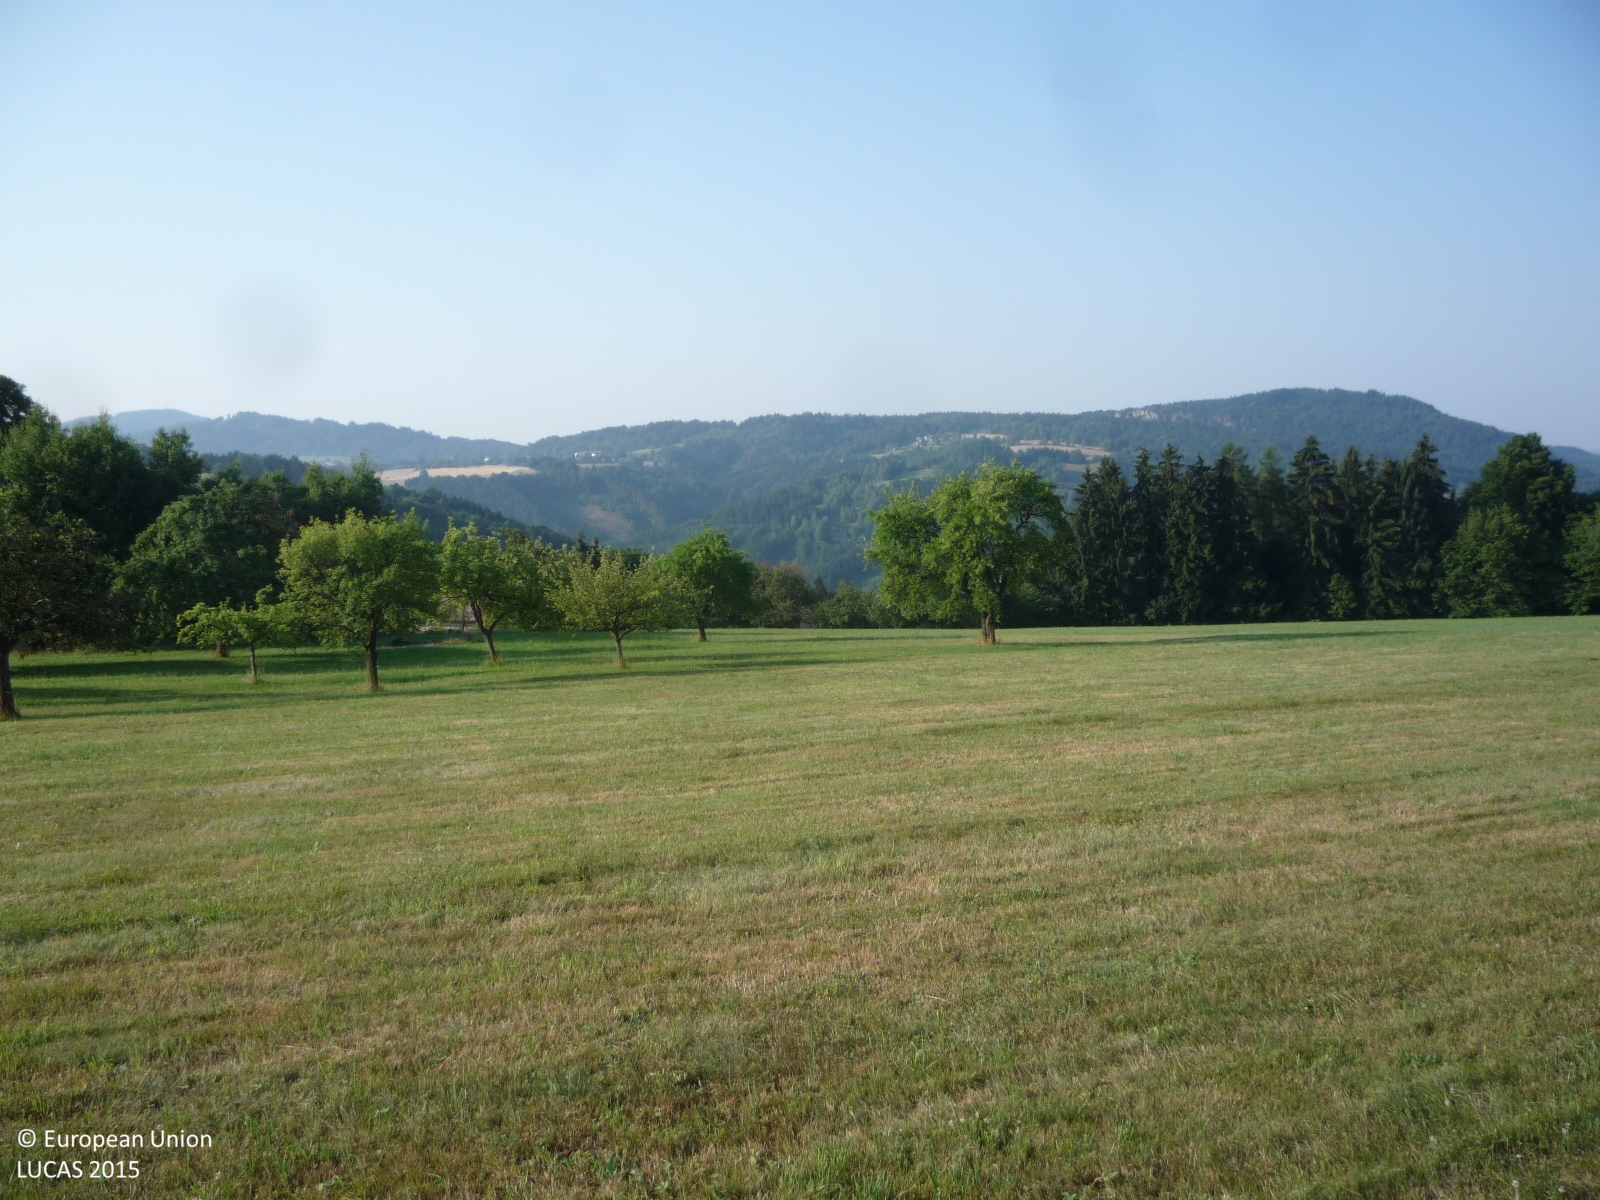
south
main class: Grassland
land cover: Grassland without tree/shrub cover
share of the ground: > 75 %
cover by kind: herbaceous plants 100 %
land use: Agriculture (excluding fallow land and kitchen gardens)
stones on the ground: < 10 %
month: August
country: CZ
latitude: 50.6592
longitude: 15.2233
